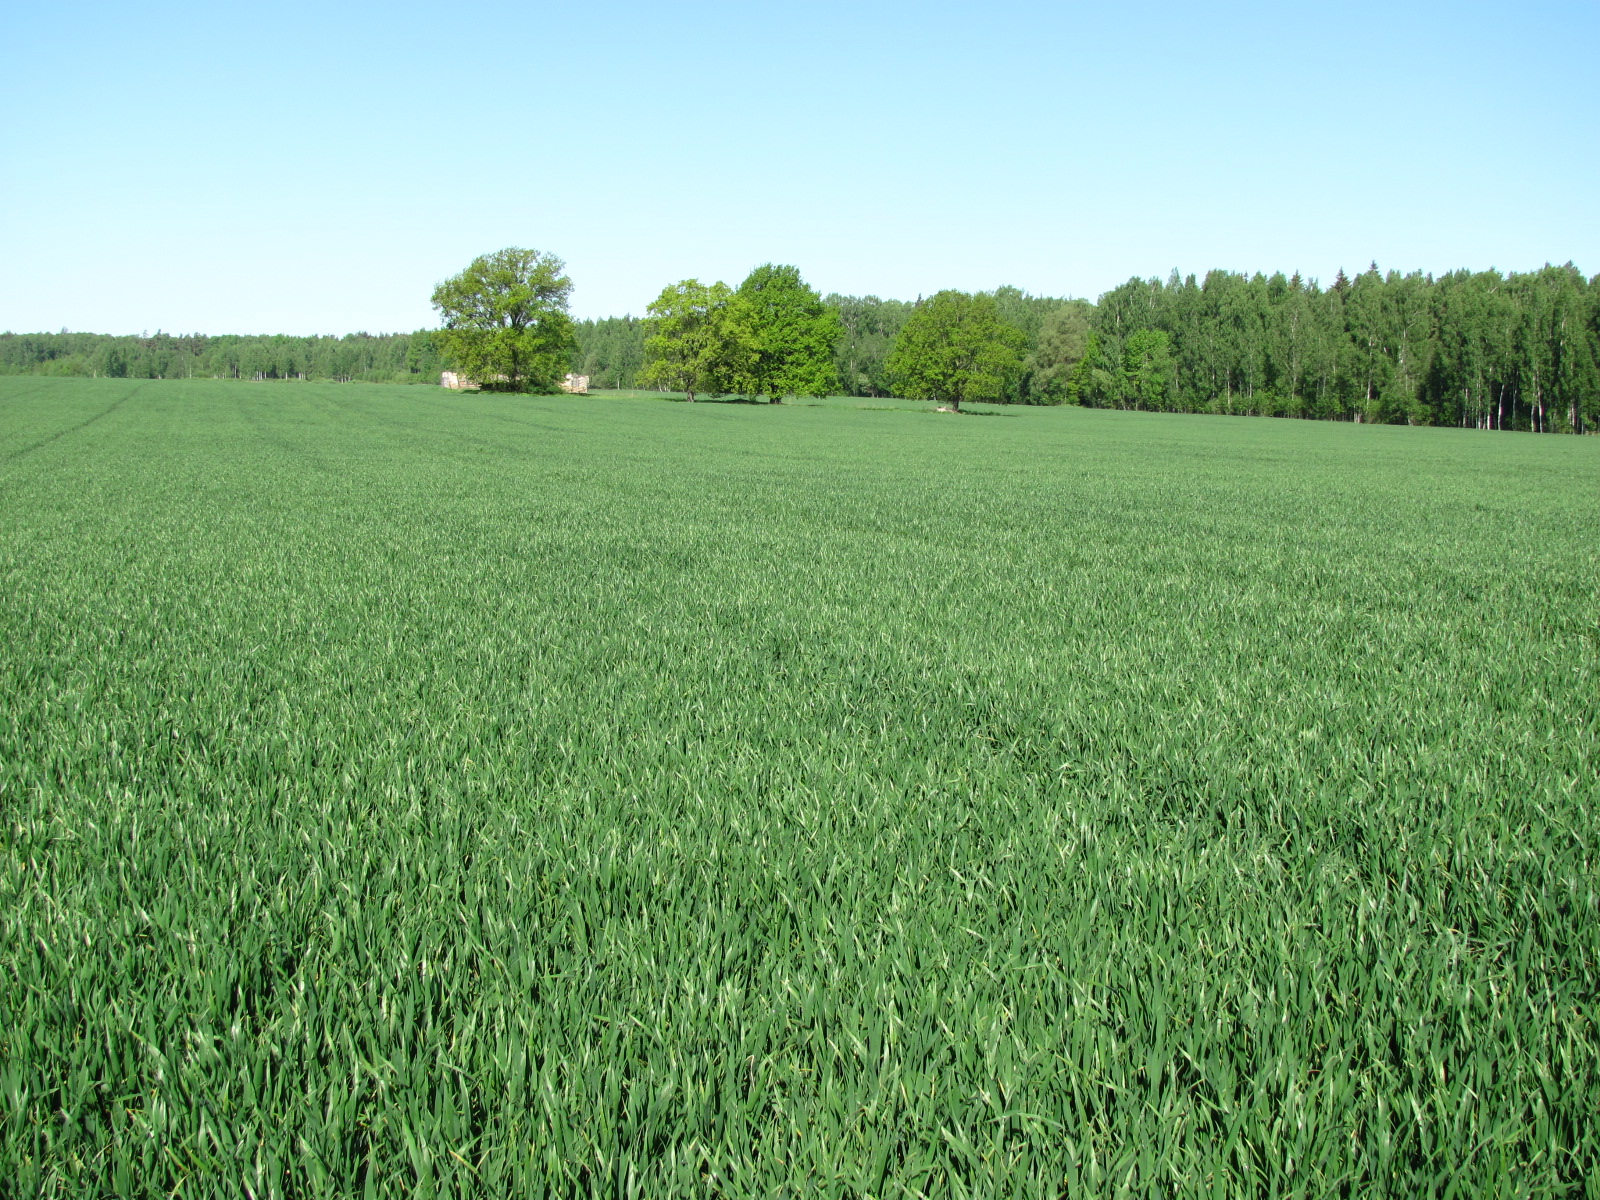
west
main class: Cropland
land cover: Common wheat
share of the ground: > 75 %
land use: Agriculture (excluding fallow land and kitchen gardens)
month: May
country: LV
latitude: 56.5741
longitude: 24.1015
